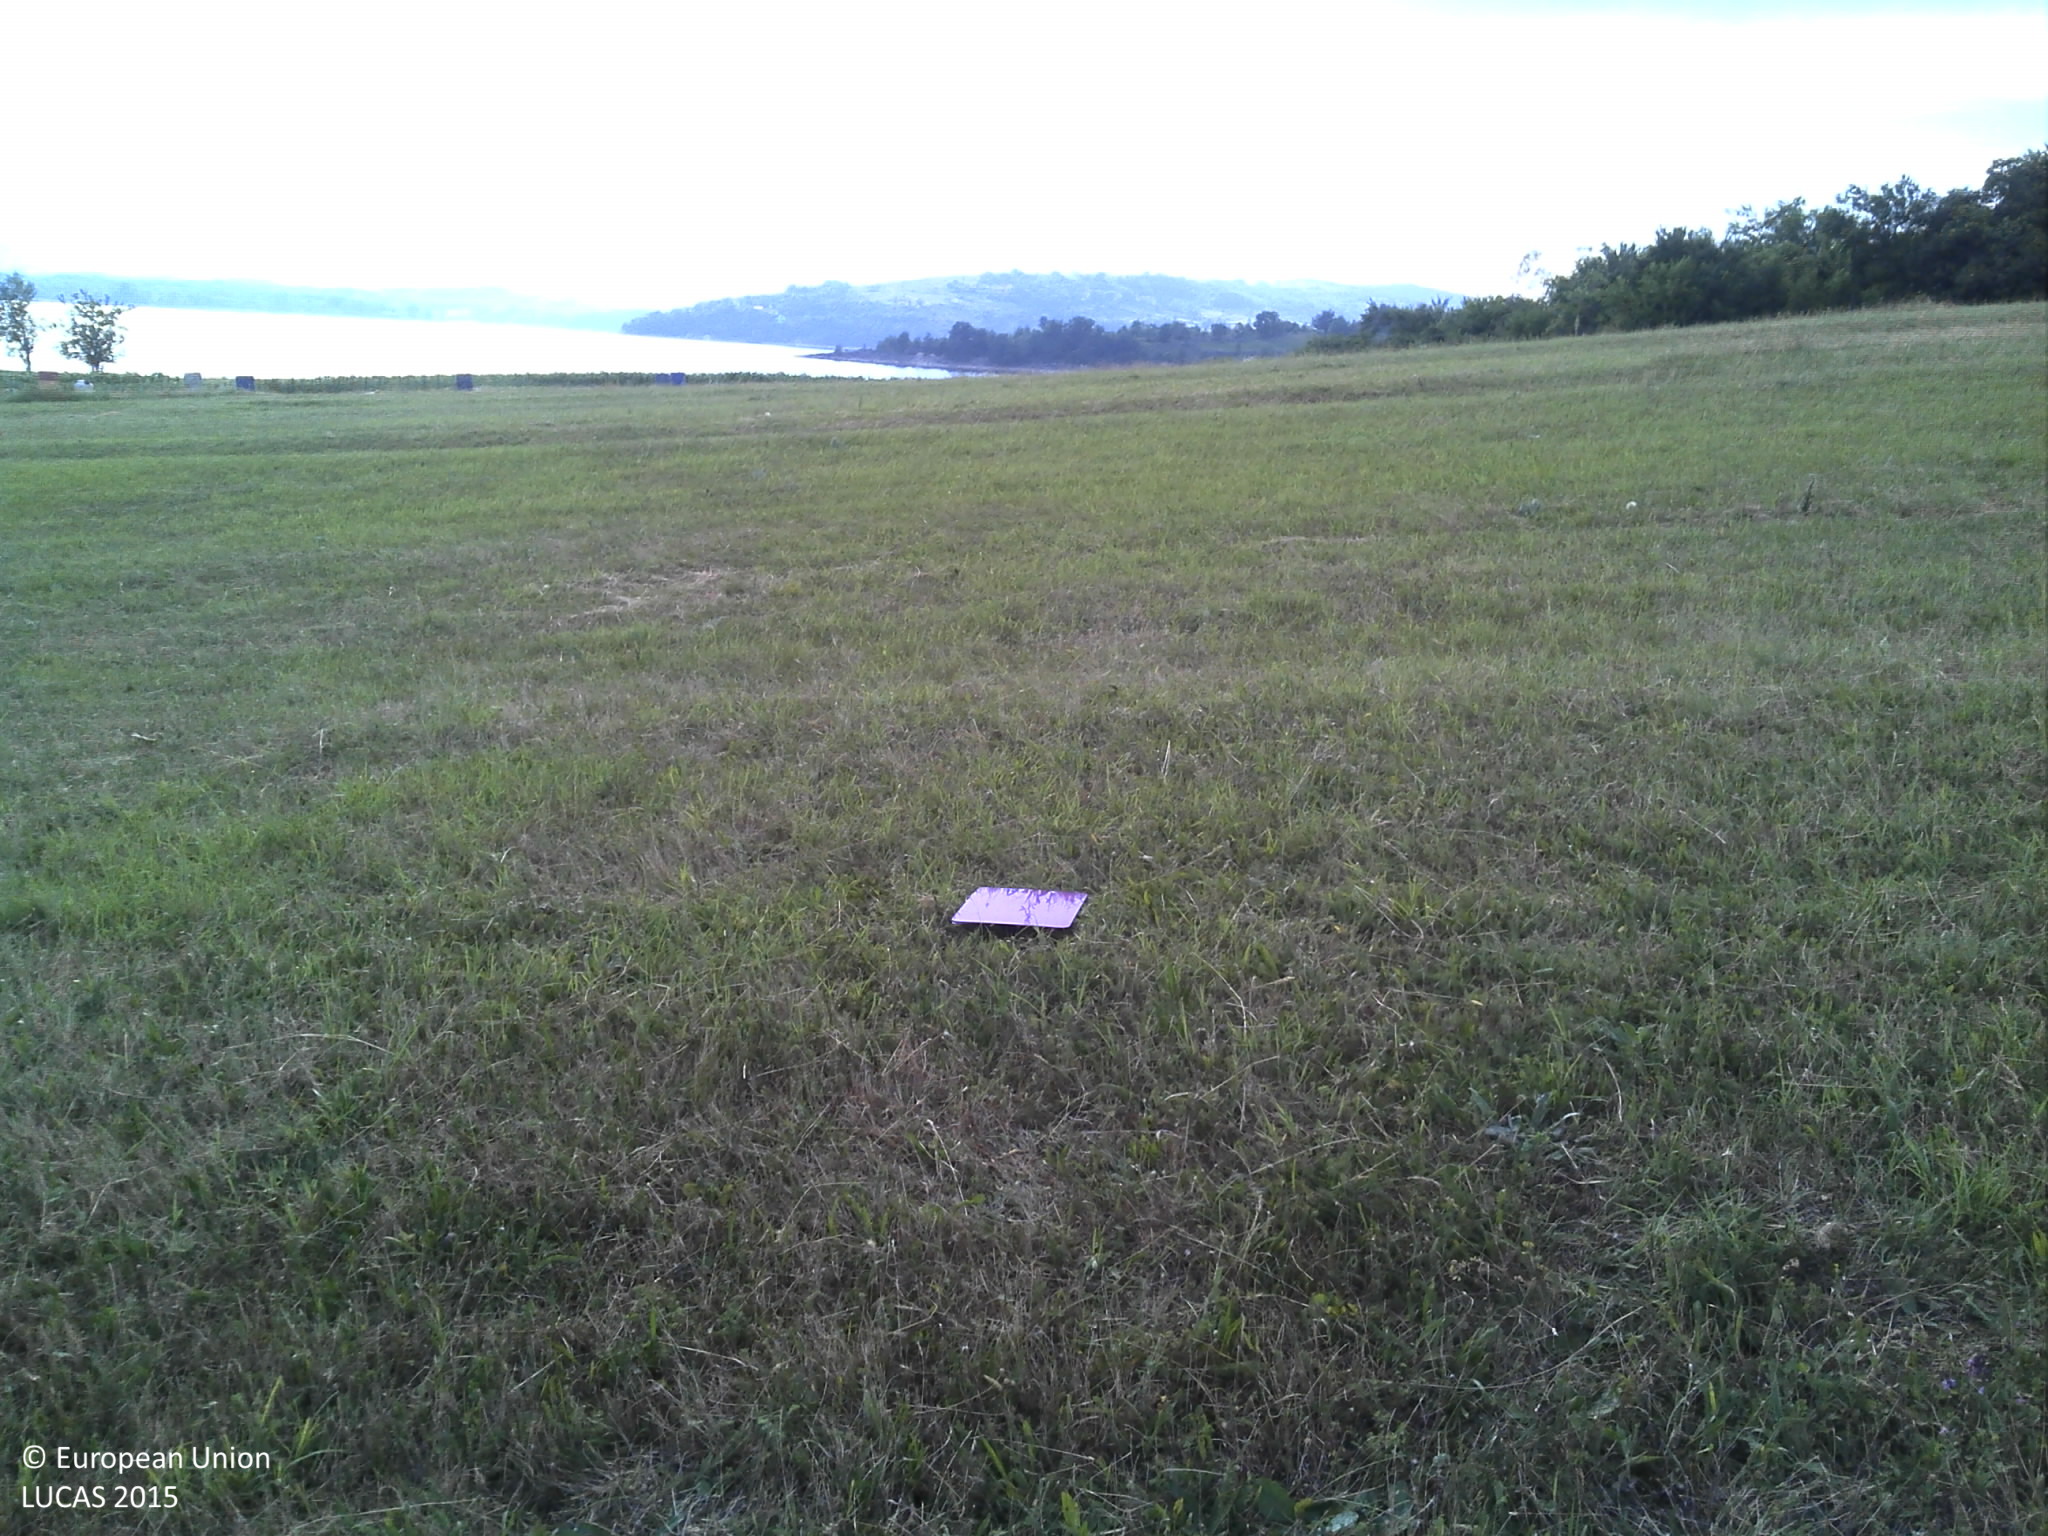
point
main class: Grassland
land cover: Grassland with sparse tree/shrub cover
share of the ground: > 75 %
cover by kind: herbaceous plants 90 %, broadleaved forest trees 5 %, shrubs 5 %
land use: Agriculture (excluding fallow land and kitchen gardens)
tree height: < 5 m
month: June
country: HR
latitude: 43.8948
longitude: 16.4783
